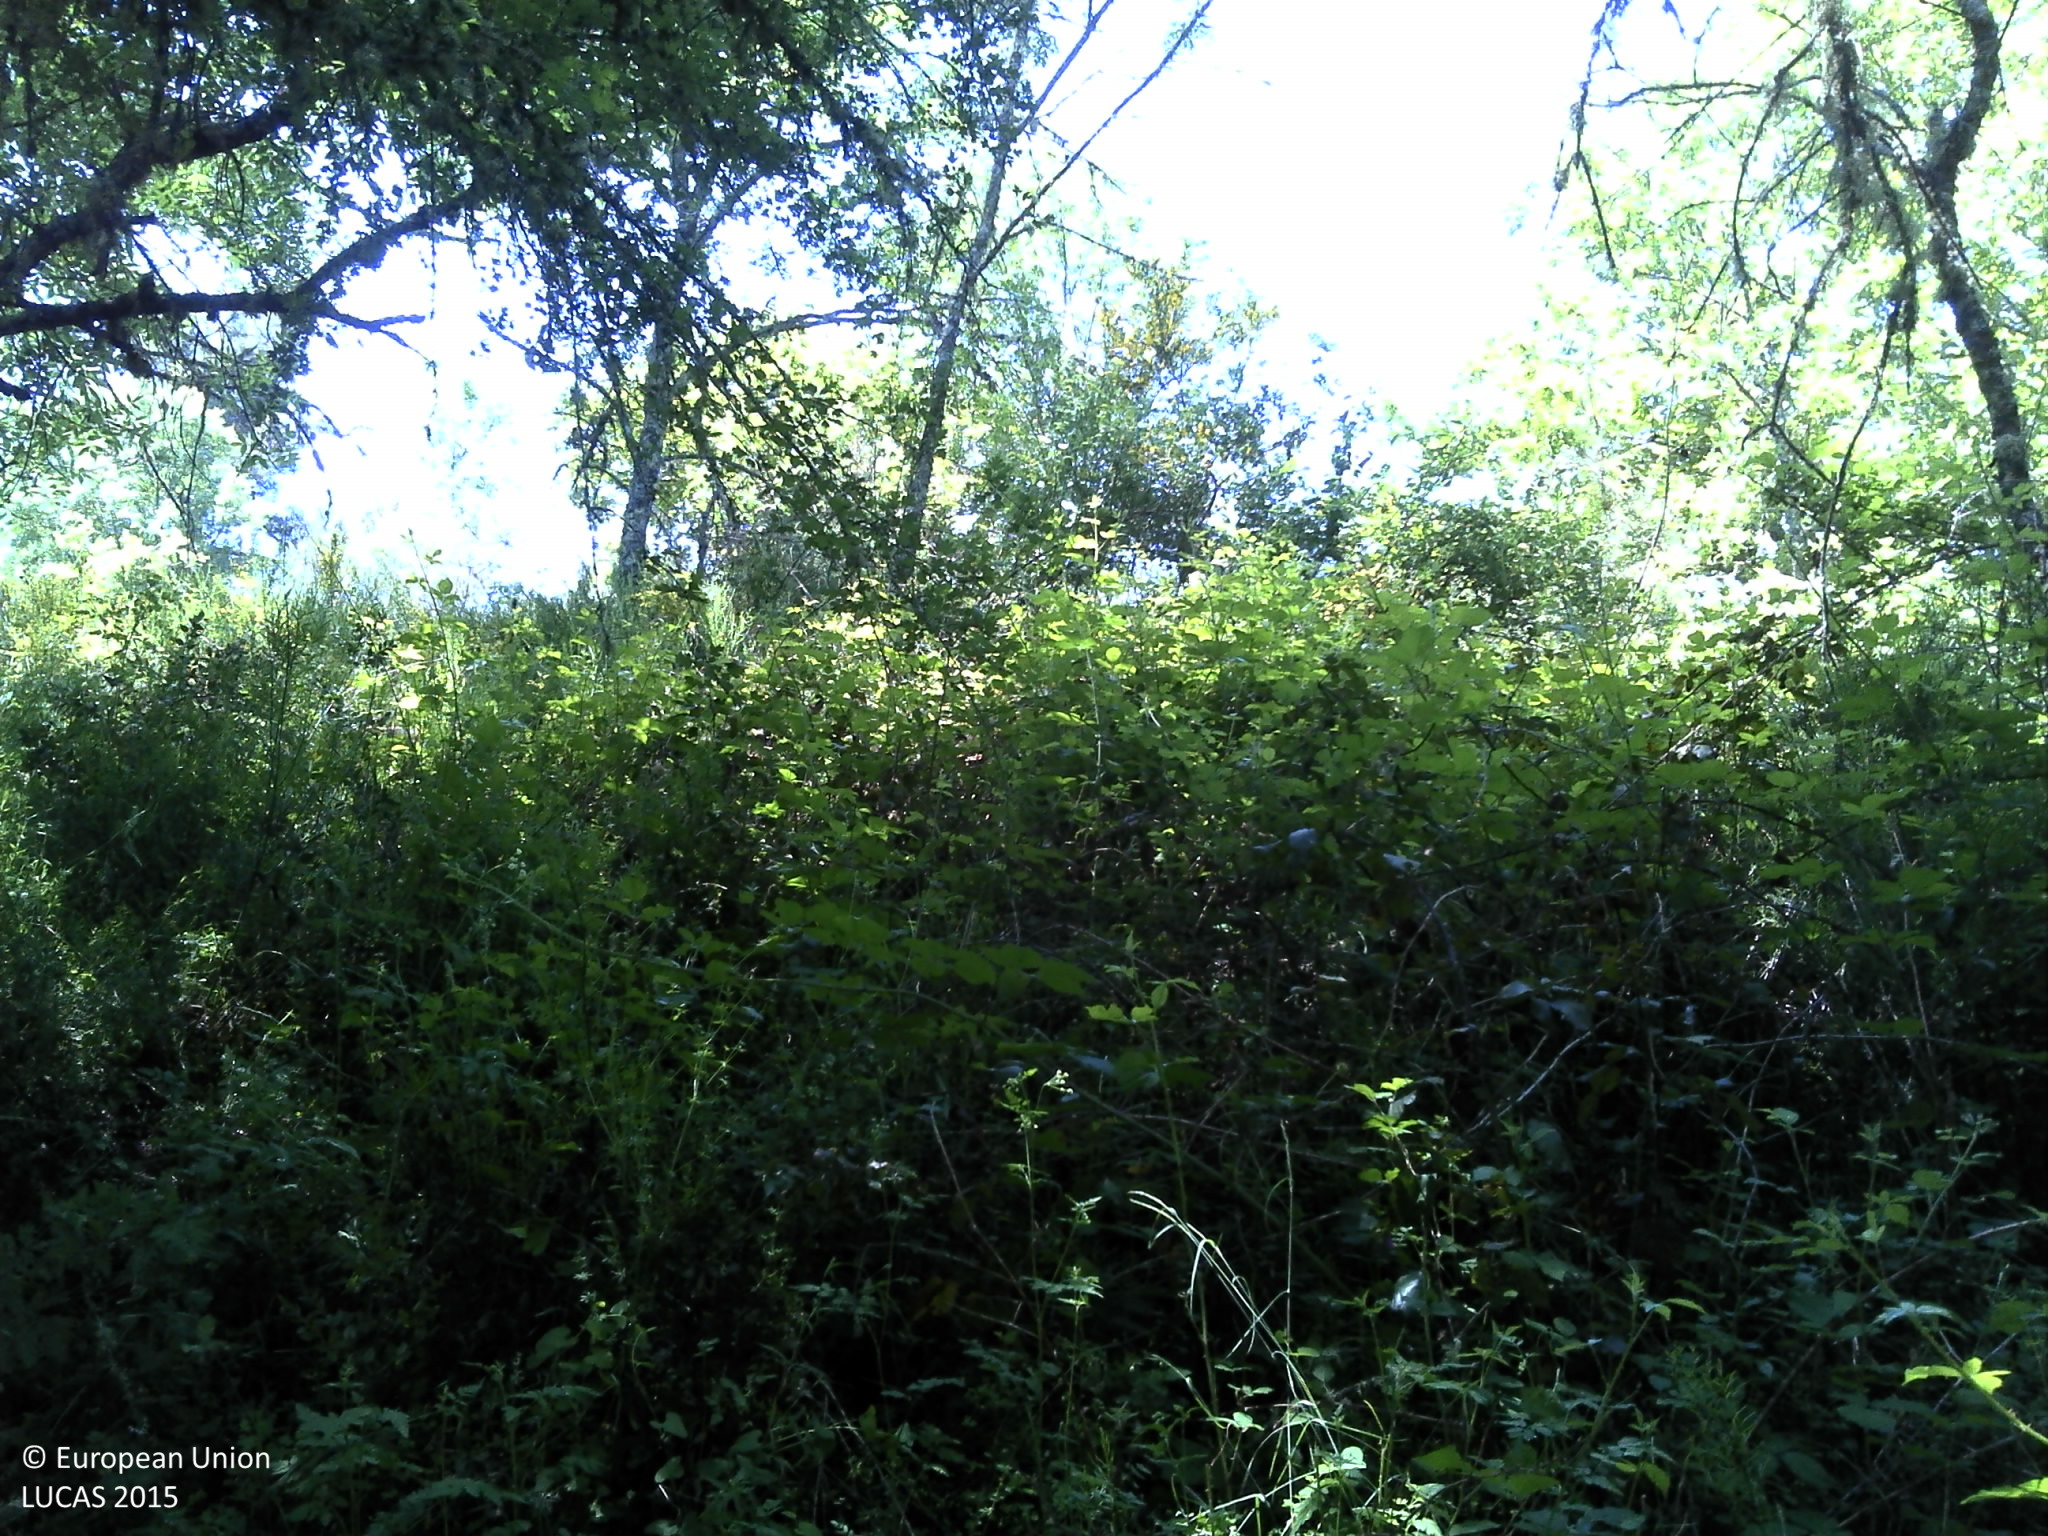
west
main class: Woodland
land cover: Broadleaved woodland
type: mesophytic deciduous forest
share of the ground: > 75 %
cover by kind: broadleaved forest trees 70 %, shrubs 25 %, herbaceous plants 5 %
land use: Forestry
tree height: > 5 m
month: May
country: PT
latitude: 41.6328
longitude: -7.4991
